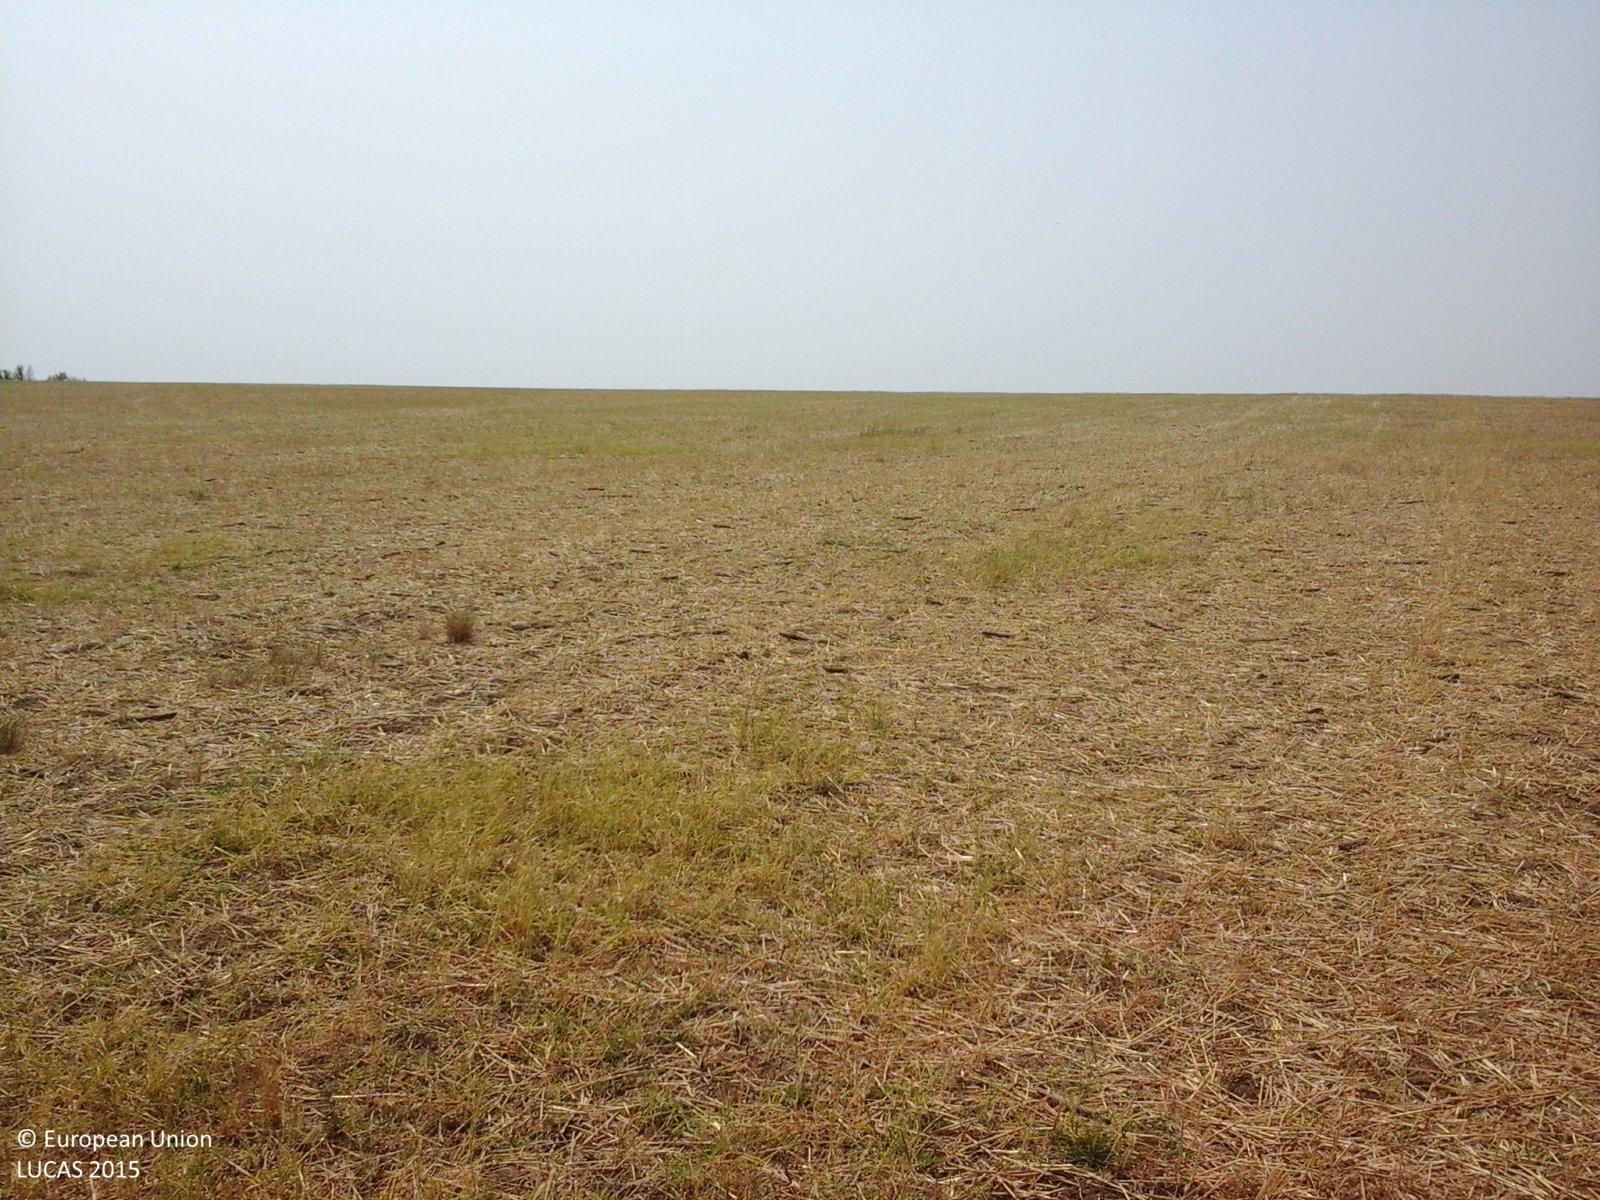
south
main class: Cropland
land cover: Common wheat
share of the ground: 50 - 75 %
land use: Agriculture (excluding fallow land and kitchen gardens)
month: August
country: RO
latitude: 44.3037
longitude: 23.5018
